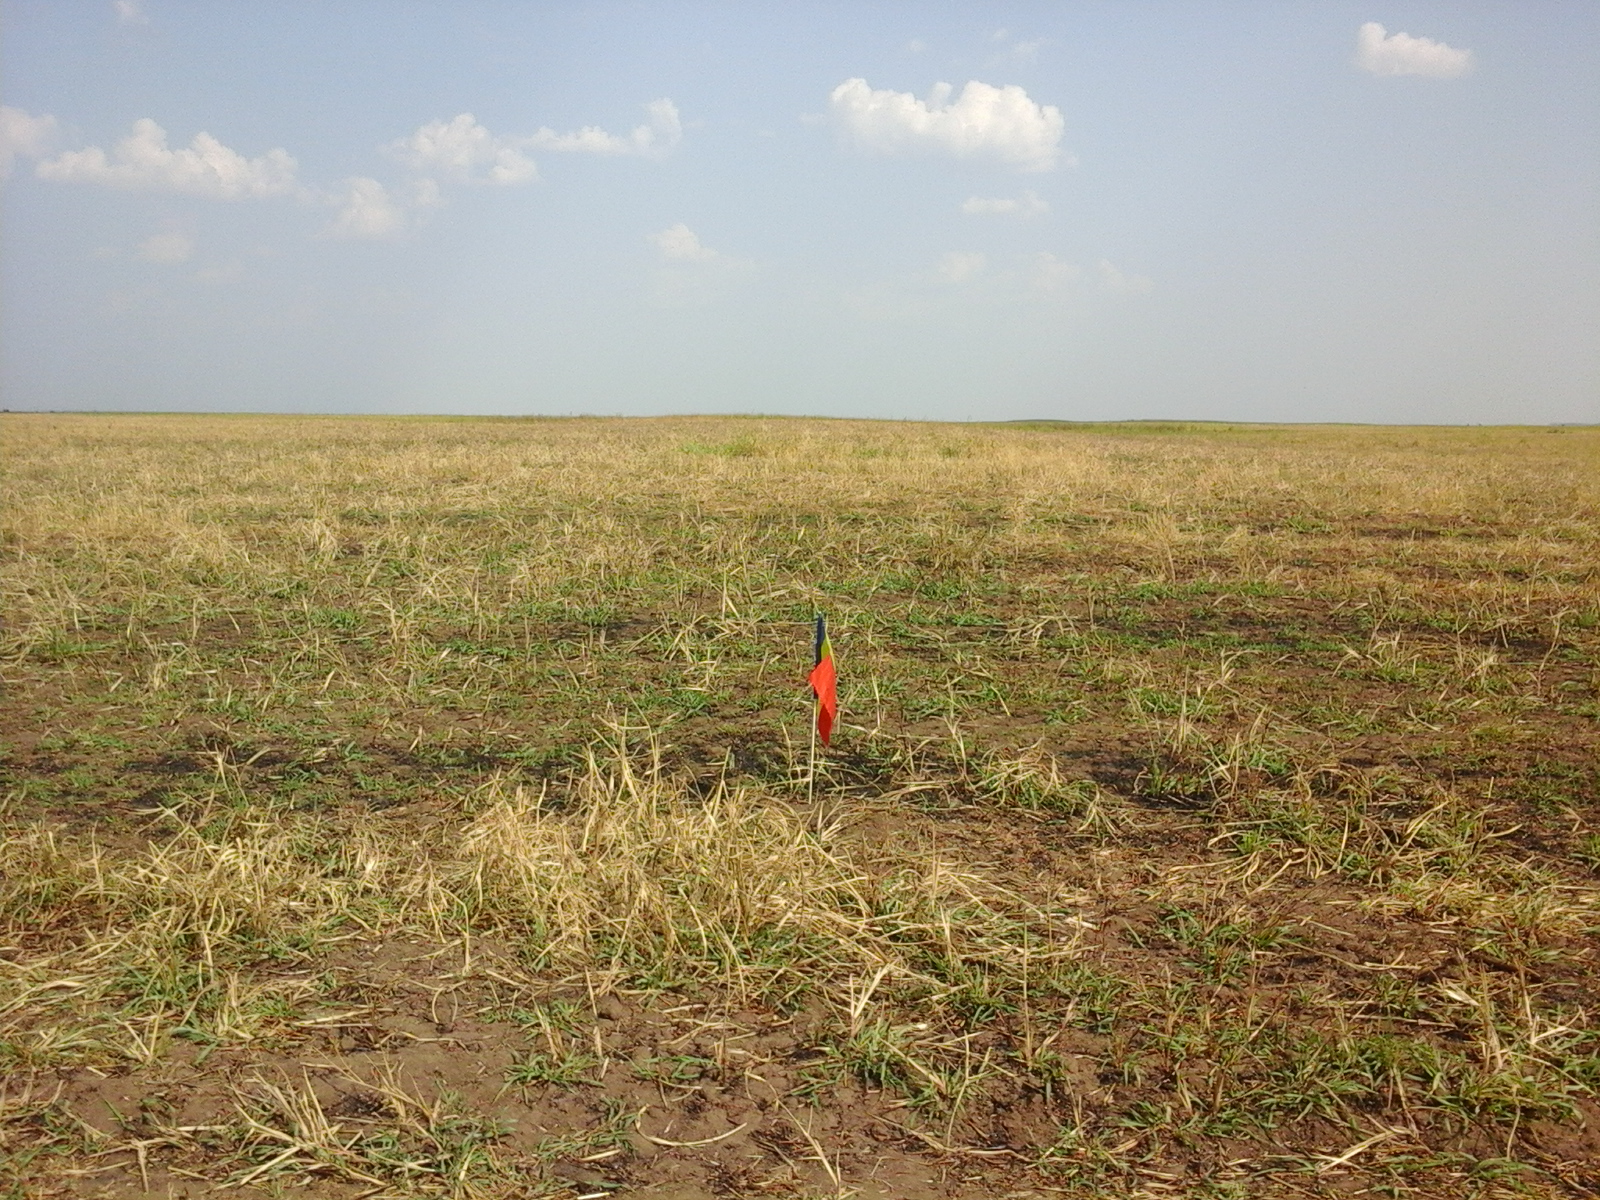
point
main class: Cropland
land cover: Common wheat
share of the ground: 50 - 75 %
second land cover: Spontaneously vegetated surfaces
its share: > 75 %
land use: Agriculture (excluding fallow land and kitchen gardens)
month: August
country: RO
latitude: 43.9850
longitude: 23.4257
